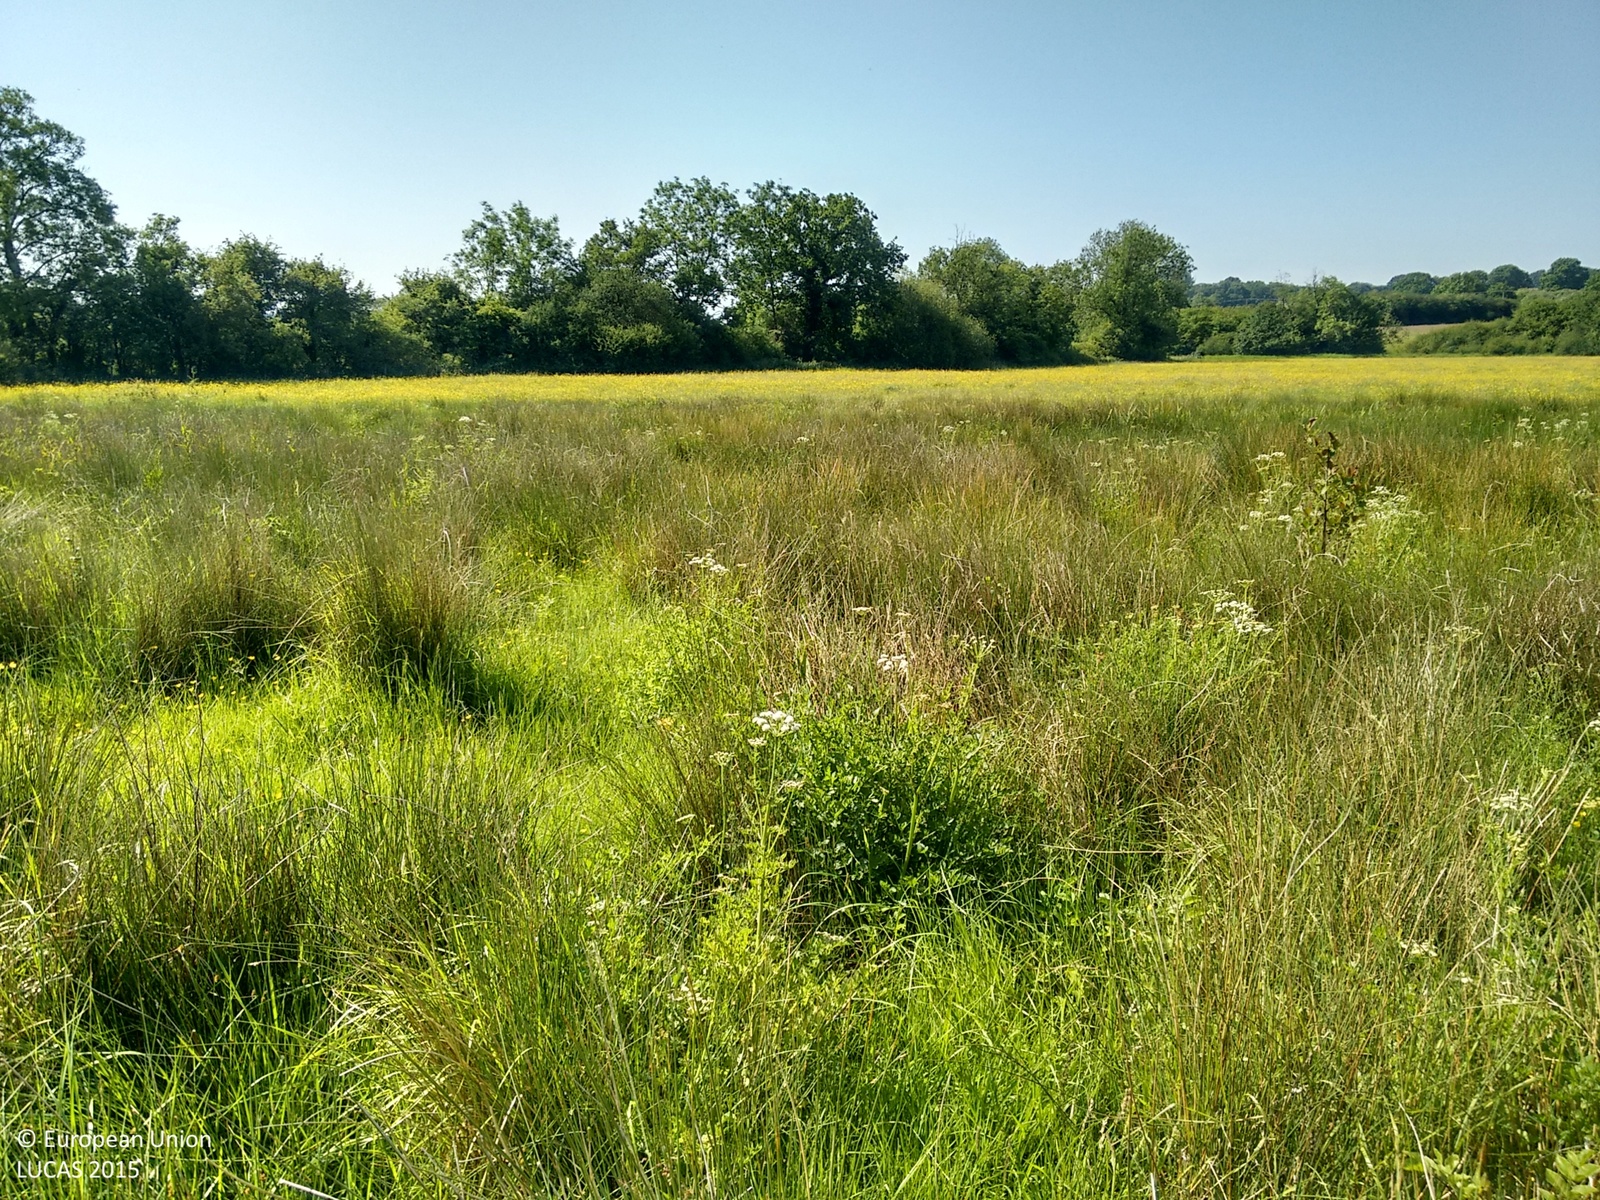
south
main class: Grassland
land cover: Grassland without tree/shrub cover
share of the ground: > 75 %
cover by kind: herbaceous plants 100 %
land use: Agriculture (excluding fallow land and kitchen gardens)
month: June
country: GB
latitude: 50.9973
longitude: 0.4679
